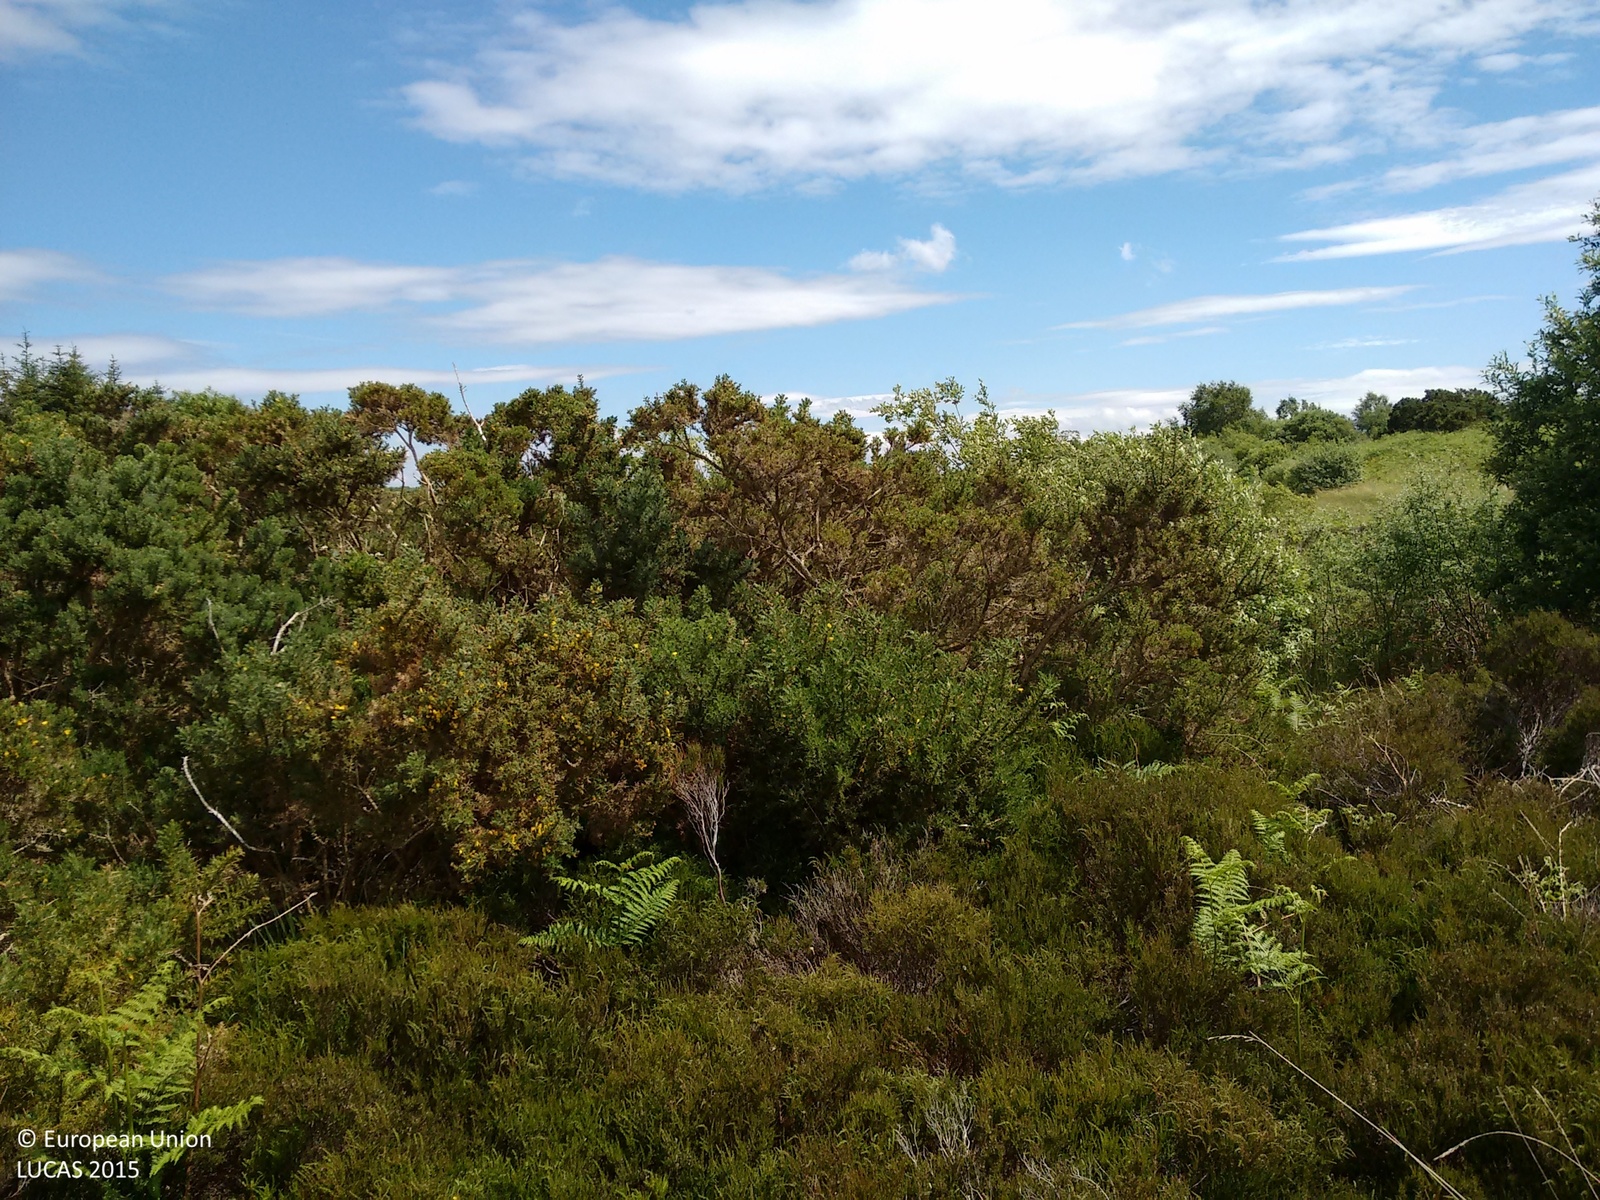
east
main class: Shrubland
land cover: Shrubland with sparse tree cover
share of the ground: > 75 %
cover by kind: shrubs 80 %, lichens and mosses 10 %, broadleaved forest trees 5 %, herbaceous plants 5 %
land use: Semi-natural and natural areas not in use
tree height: < 5 m
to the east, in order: Shrubland with sparse tree cover; Ditches and canals; Grassland with sparse tree/shrub cover; Broadleaved woodland; Ditches and canals; Tracks; Peatbogs; Broadleaved woodland; Peatbogs; Broadleaved woodland; Peatbogs; Ditches and canals; Peatbogs; Shrubland with sparse tree cover; Shrubland without tree cover; Peatbogs
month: June
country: IE
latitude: 53.4280
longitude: -8.0722
